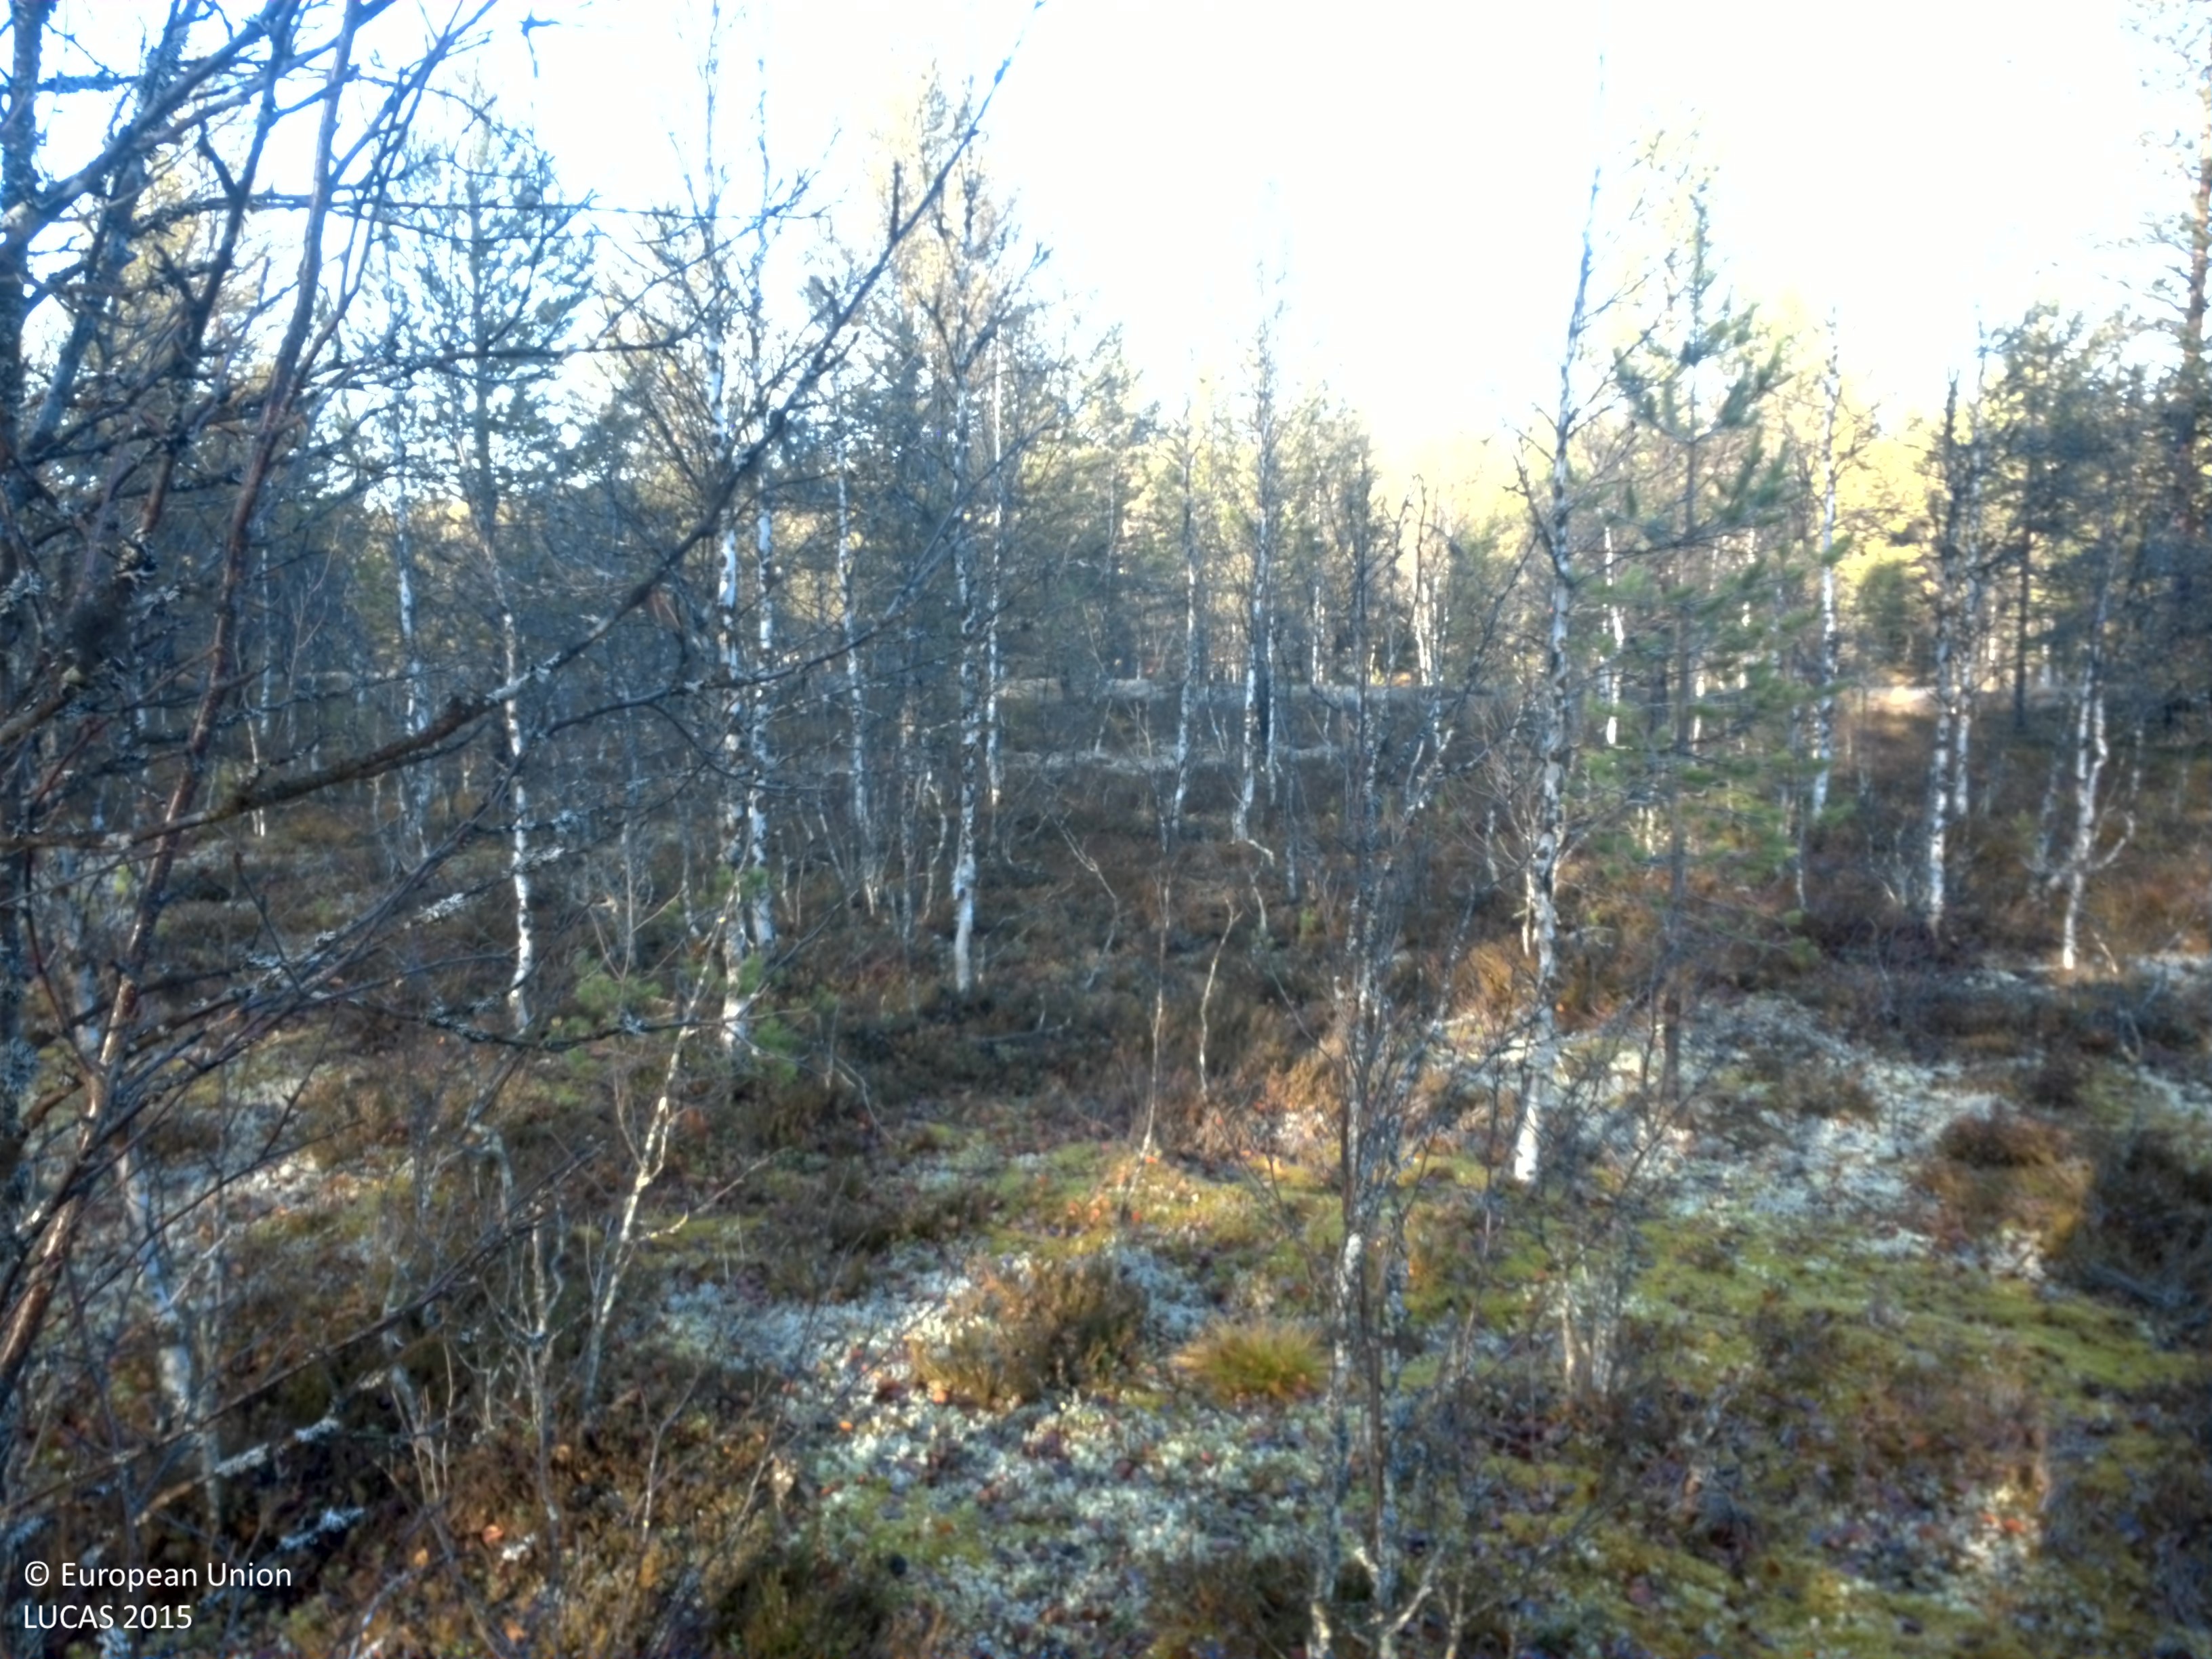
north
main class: Woodland
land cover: Pine dominated mixed woodland
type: boreal forest
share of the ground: 25 - 50 %
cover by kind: shrubs 40 %, lichens and mosses 30 %, coniferous forest trees 20 %, broadleaved forest trees 10 %
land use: Forestry
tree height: > 5 m
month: October
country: SE
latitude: 64.4958
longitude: 17.4399
